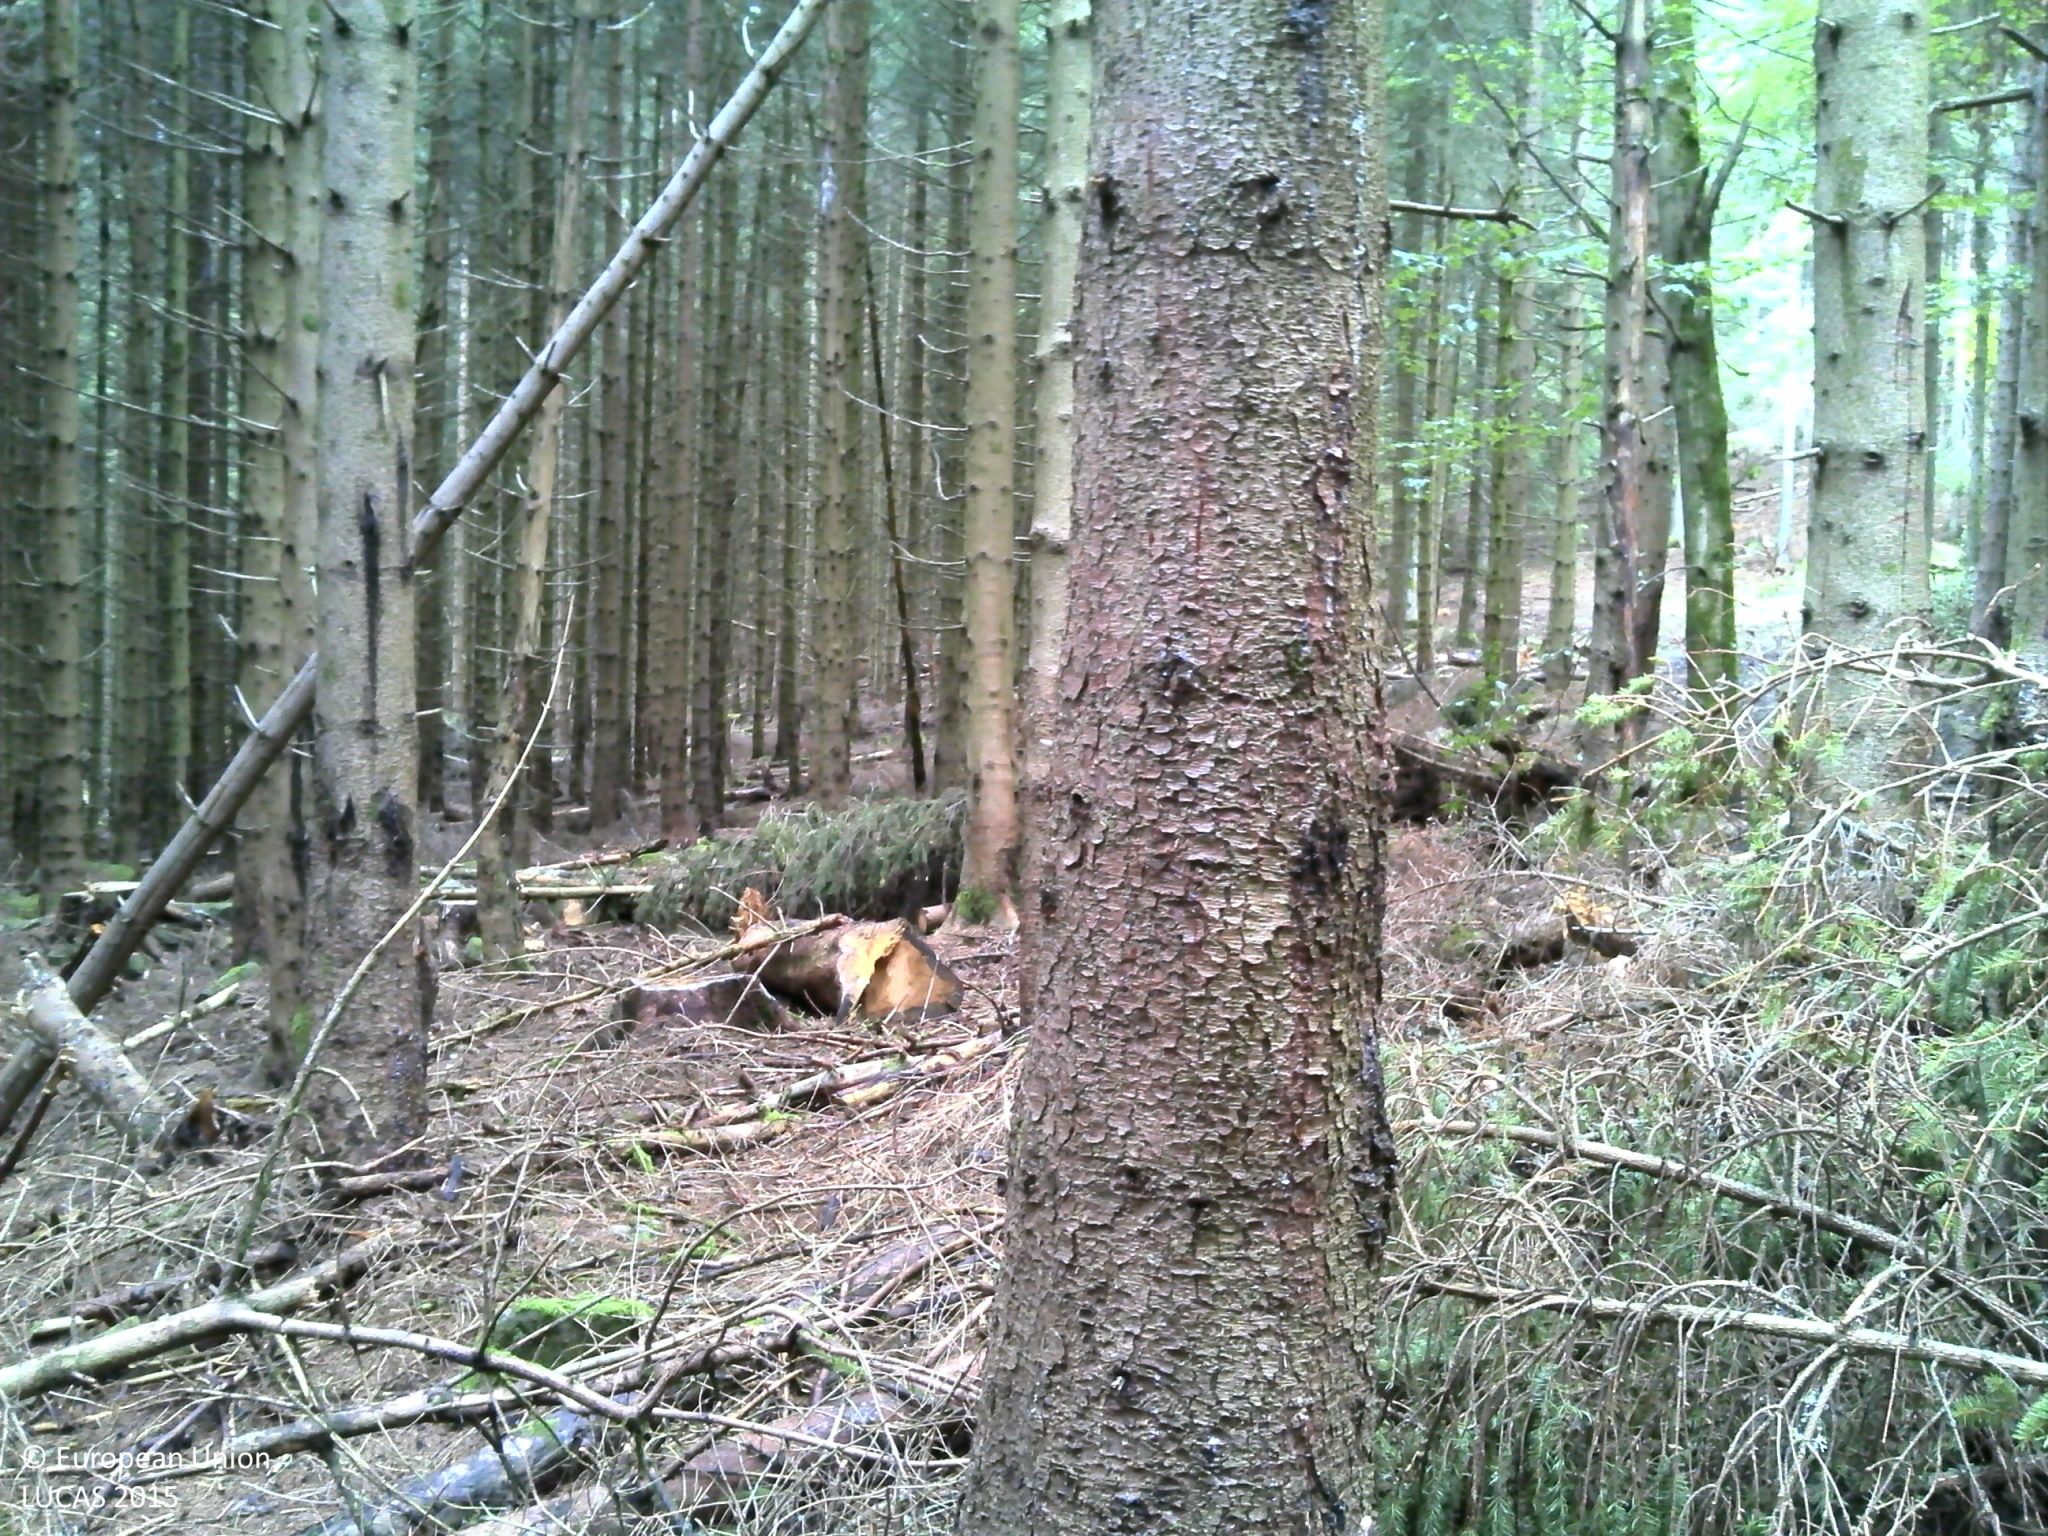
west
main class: Woodland
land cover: Spruce dominated coniferous woodland
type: exotic forest
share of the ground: > 75 %
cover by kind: coniferous forest trees 90 %, consolidated bare surface 10 %
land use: Forestry
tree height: > 5 m
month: September
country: FR
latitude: 48.4255
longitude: 7.3386
